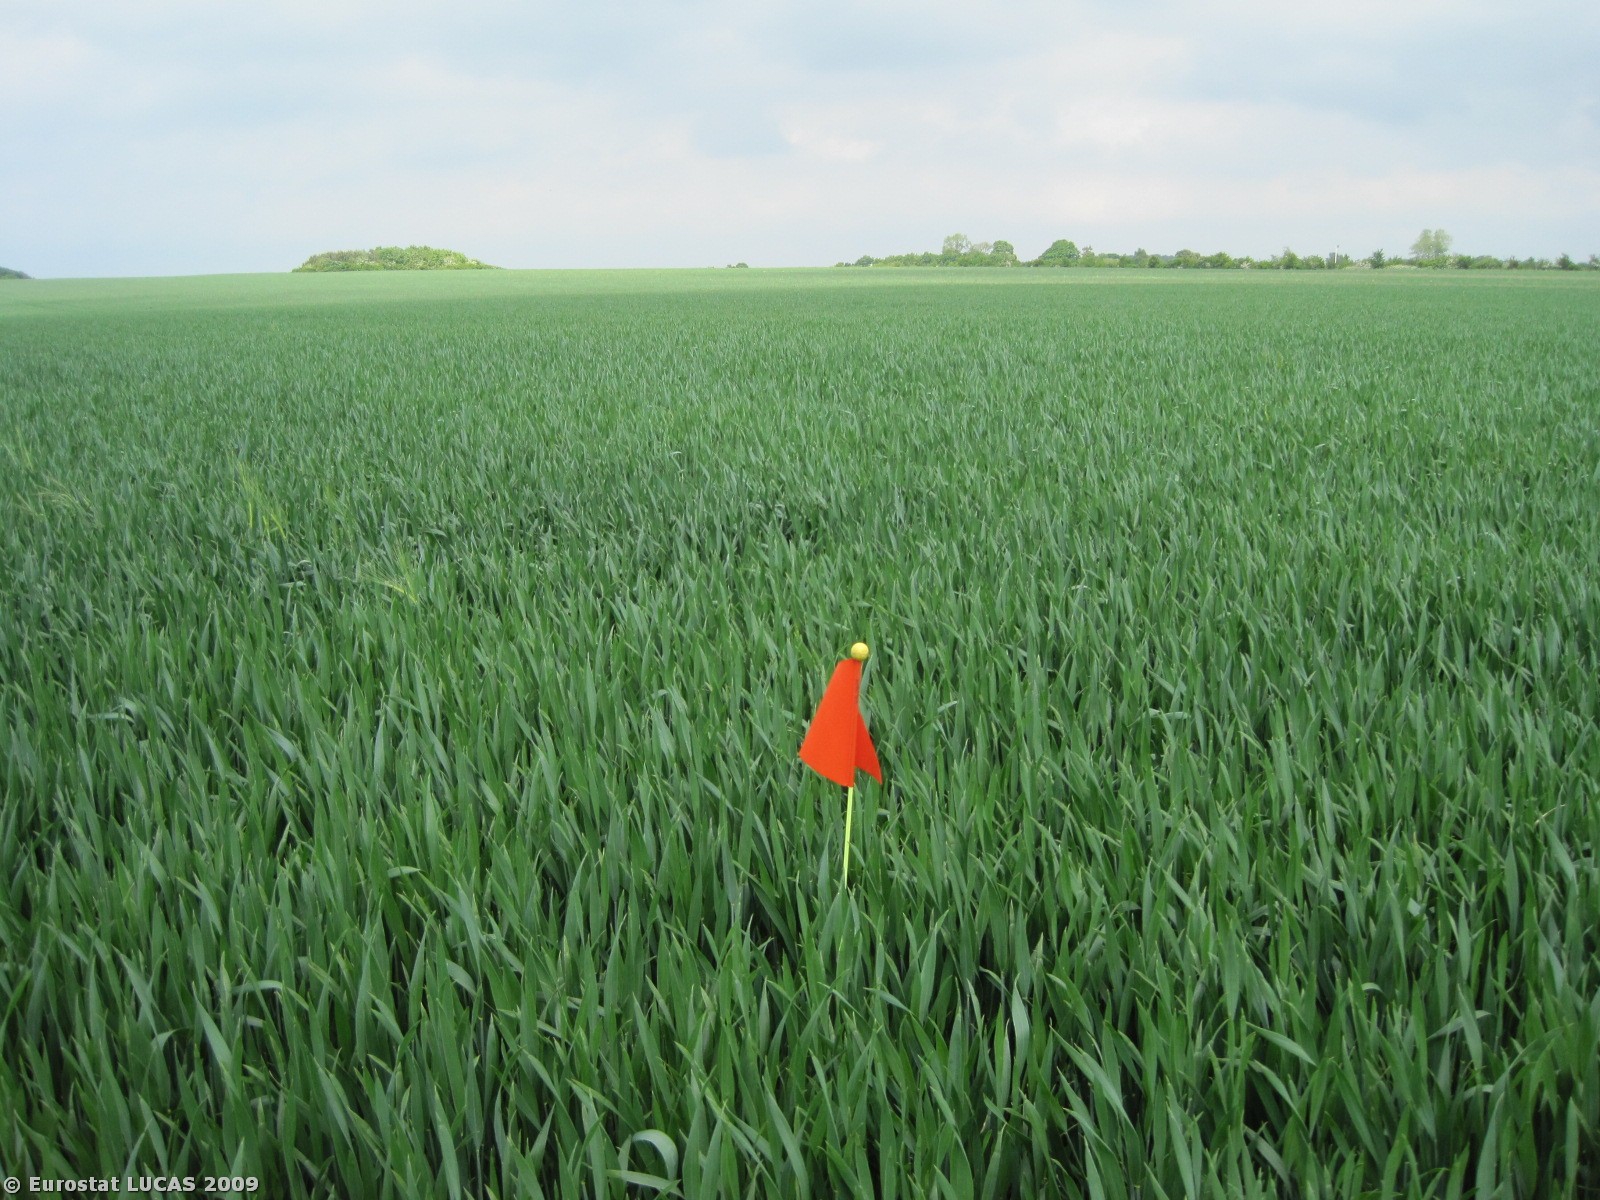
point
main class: Cropland
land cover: Common wheat
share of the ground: 50 - 75 %
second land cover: Oats
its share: 10 - 25 %
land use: Agriculture (excluding fallow land and kitchen gardens)
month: May
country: DK
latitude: 56.4572
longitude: 9.7893
